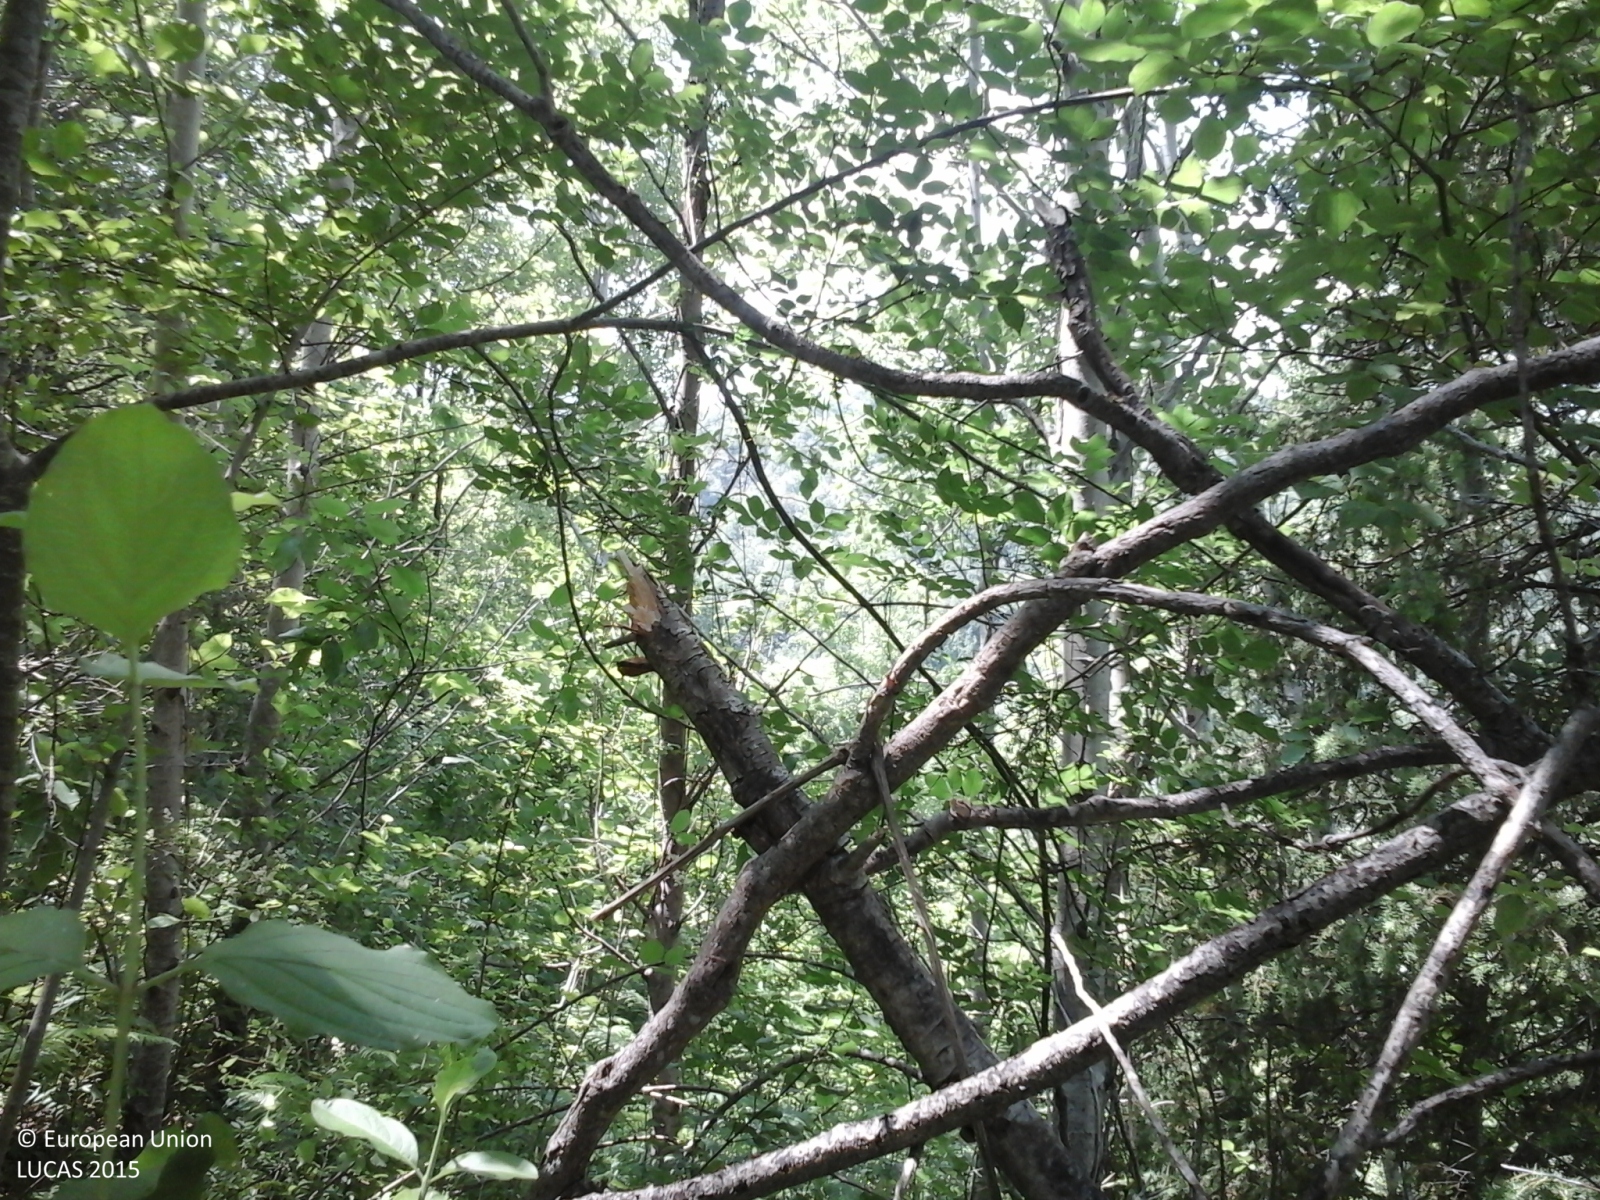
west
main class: Woodland
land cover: Broadleaved woodland
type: thermophilous deciduous forest
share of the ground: > 75 %
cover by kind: broadleaved forest trees 80 %, shrubs 10 %, herbaceous plants 10 %
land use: Abandoned areas
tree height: > 5 m
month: June
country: IT
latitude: 41.9120
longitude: 14.2898
